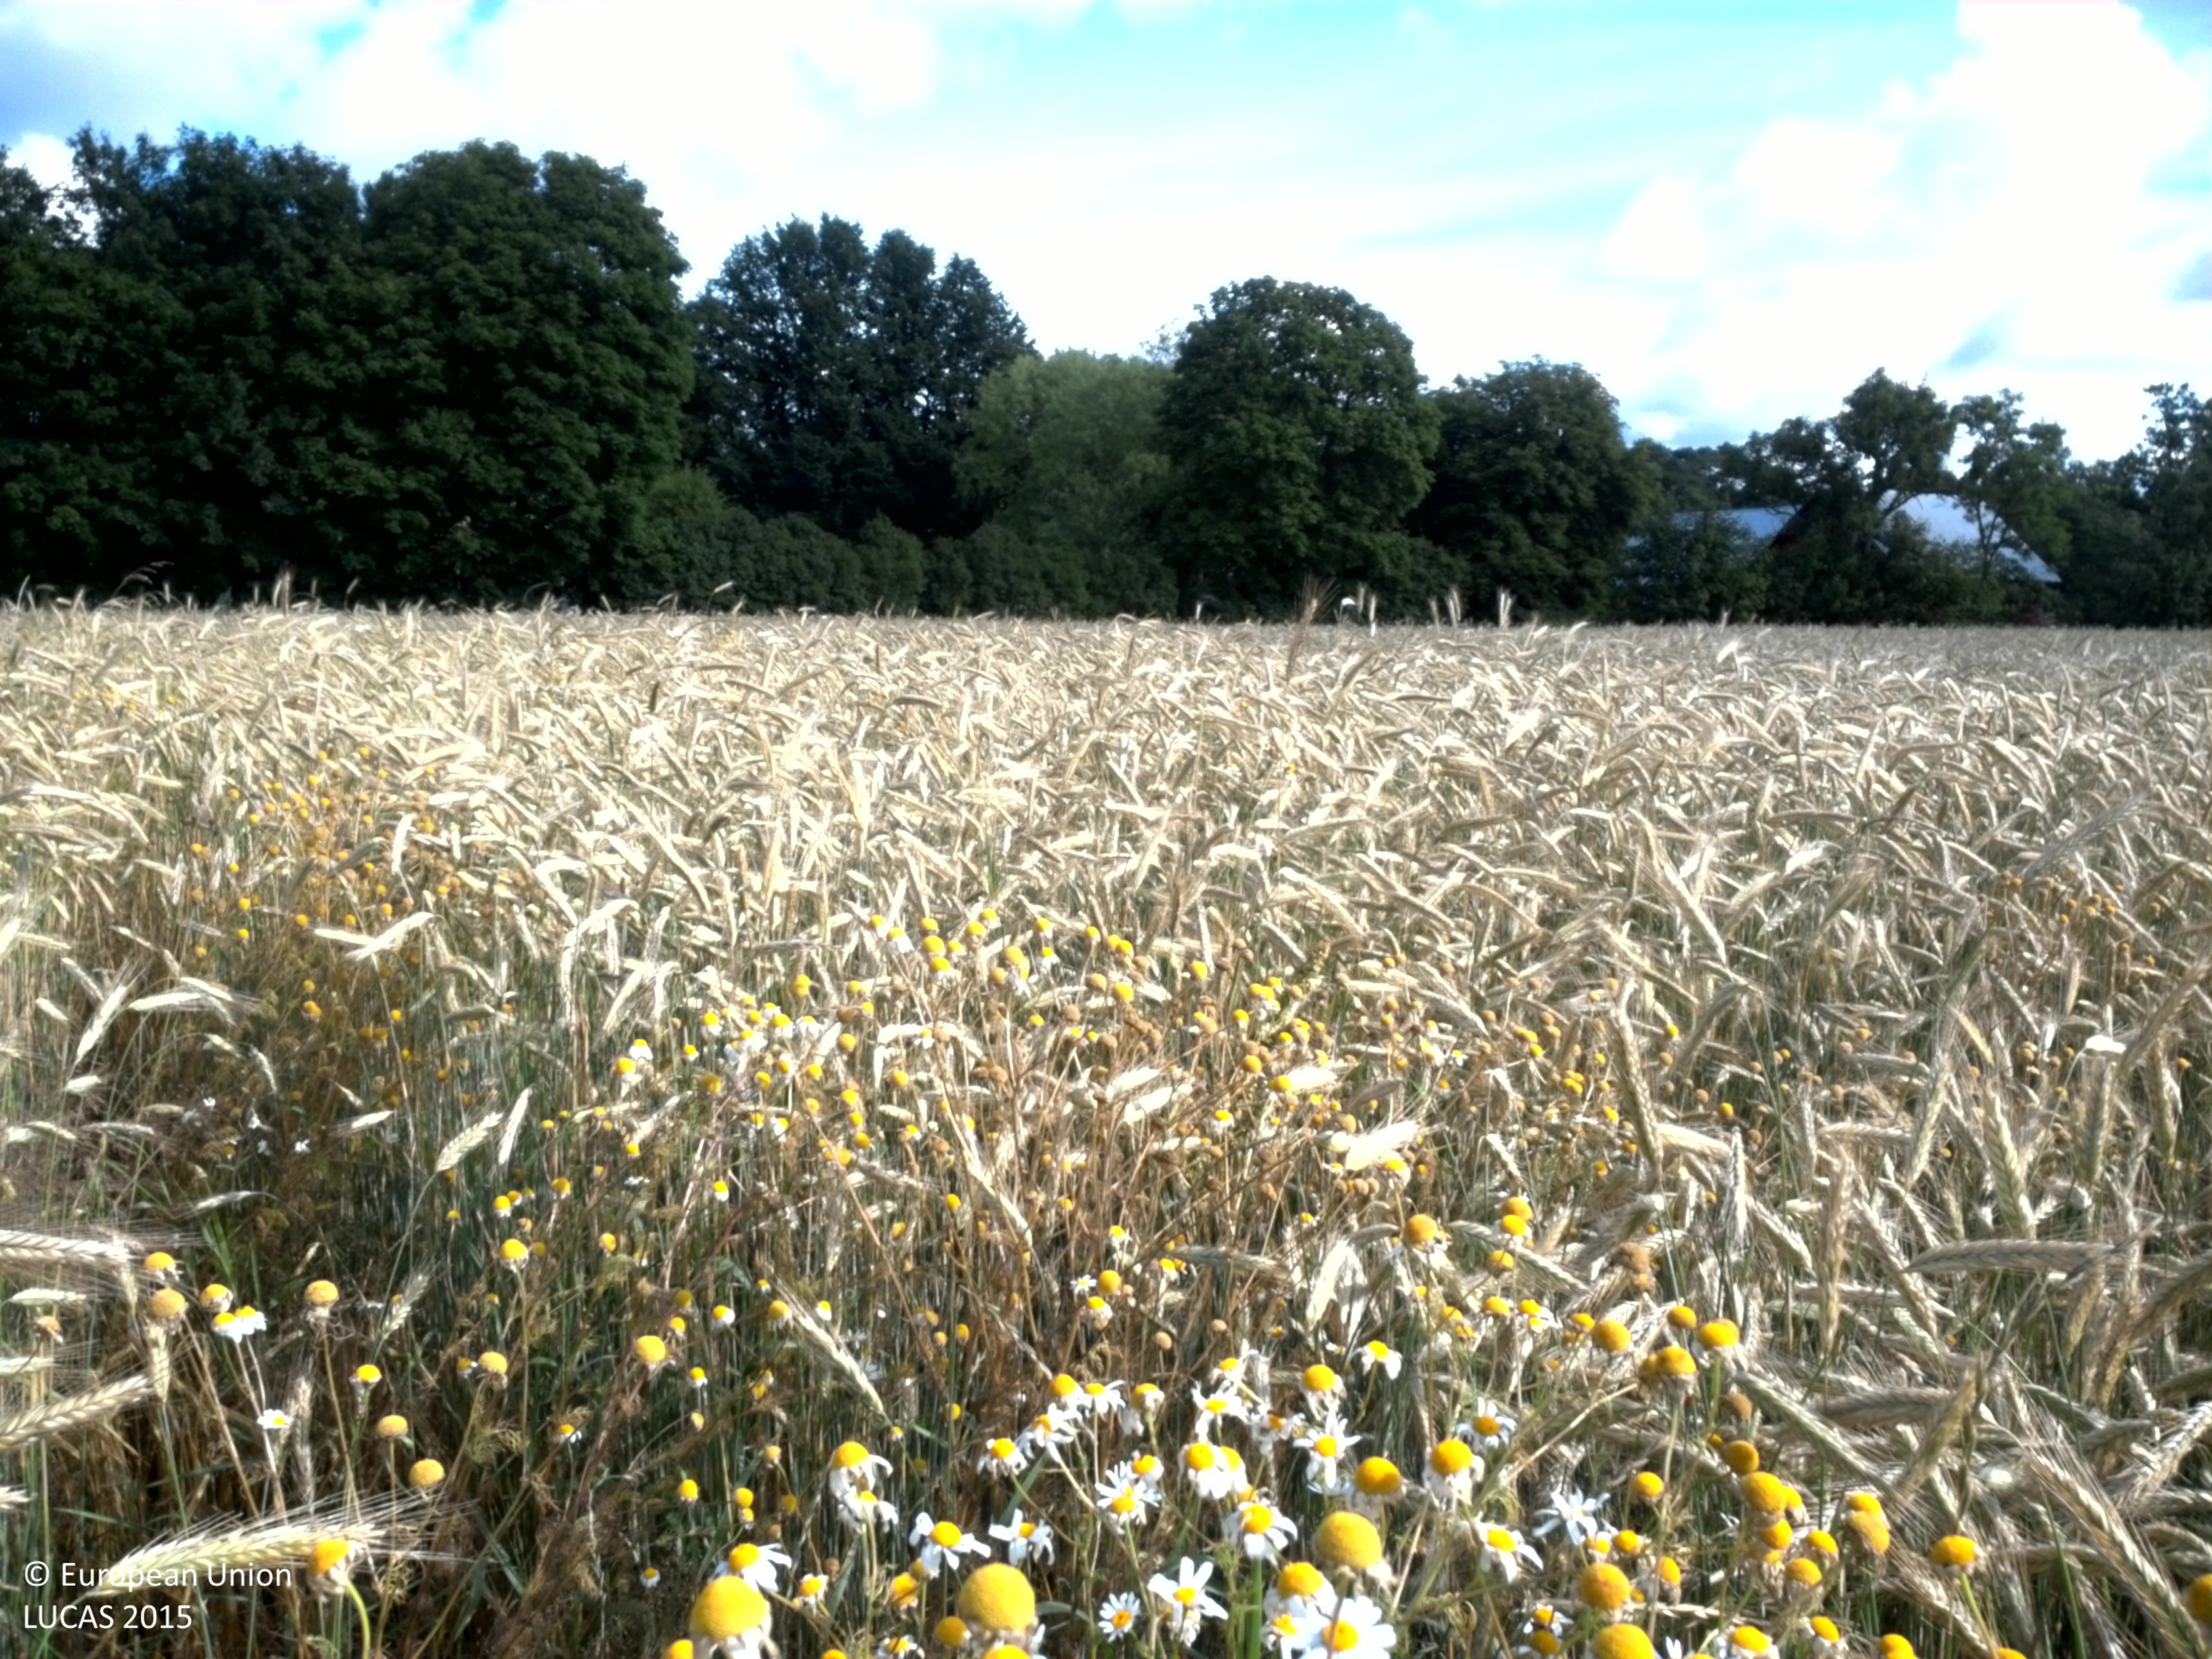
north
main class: Cropland
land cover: Rye
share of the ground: > 75 %
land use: Agriculture (excluding fallow land and kitchen gardens)
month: July
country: SE
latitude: 57.3106
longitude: 18.5928
